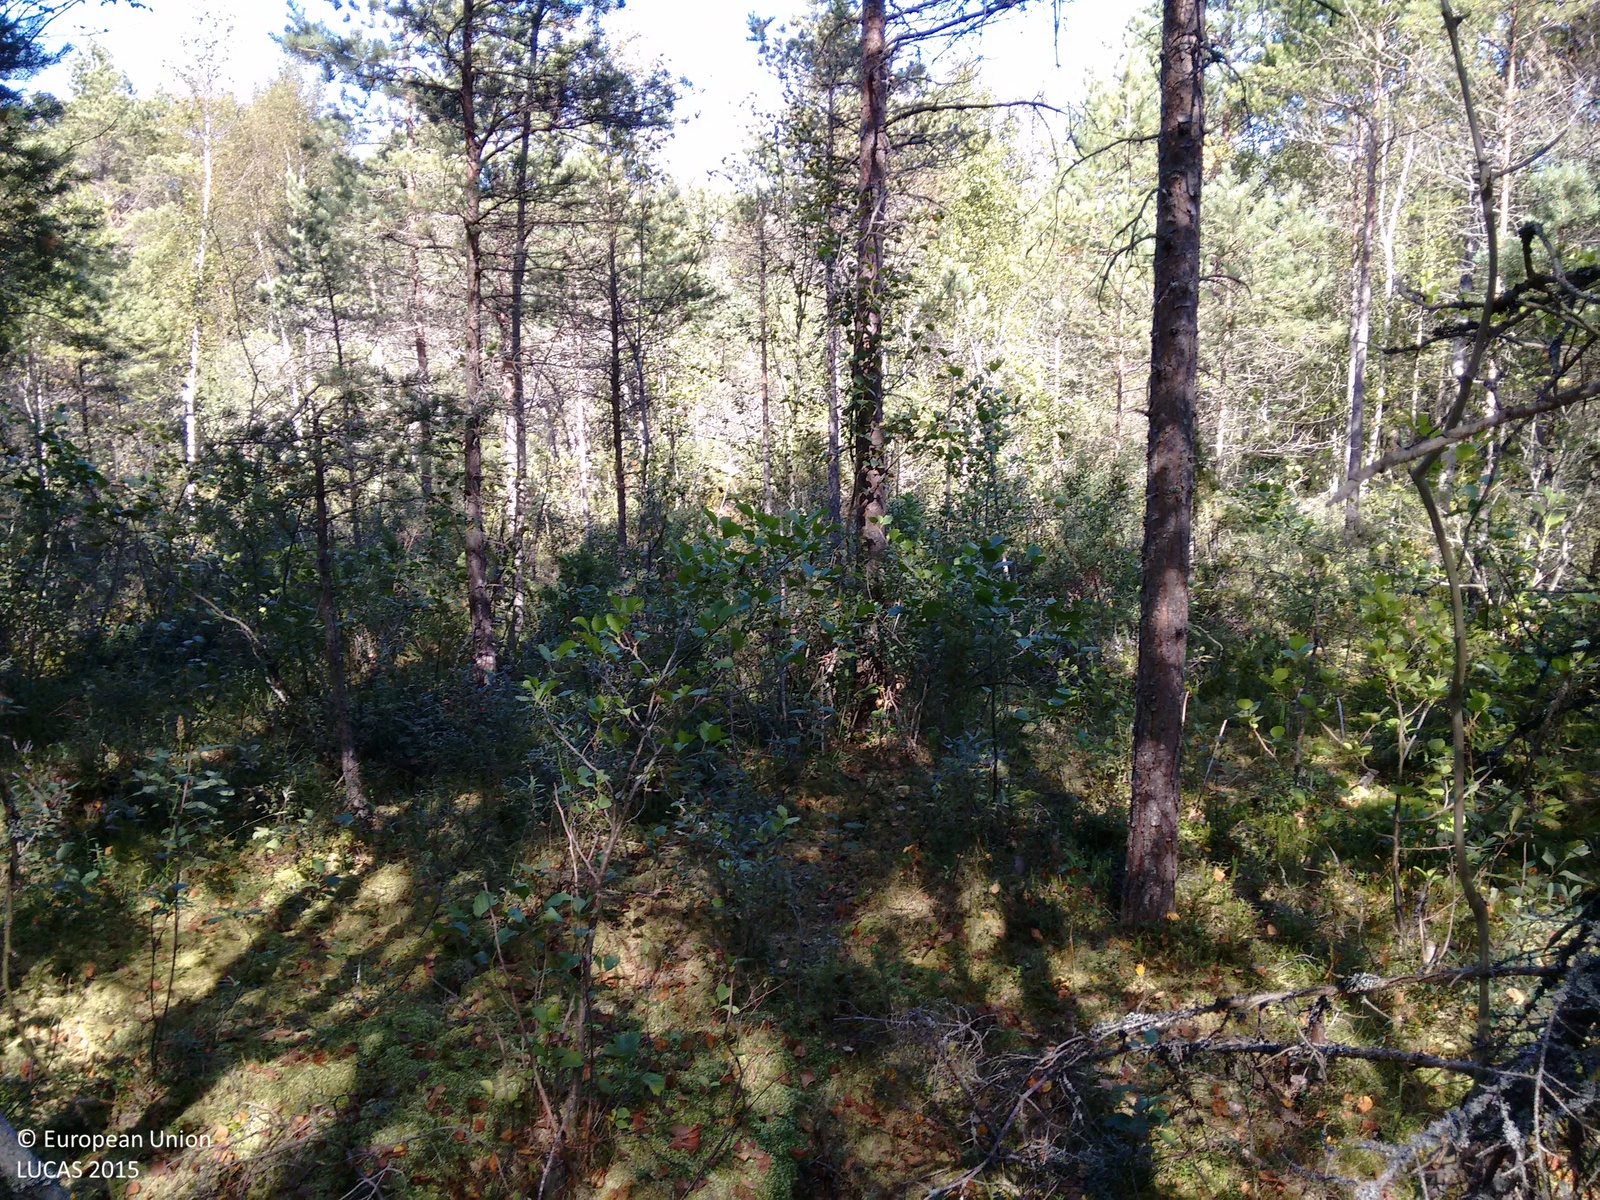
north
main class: Woodland
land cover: Pine dominated mixed woodland
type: hemiboreal forest and nemoral coniferous forest and mixed broadleaved-coniferous forest
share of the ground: > 75 %
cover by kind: coniferous forest trees 60 %, broadleaved forest trees 25 %, shrubs 5 %, herbaceous plants 5 %, lichens and mosses 5 %
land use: Forestry
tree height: > 5 m
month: August
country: FI
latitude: 60.2320
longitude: 19.6279
